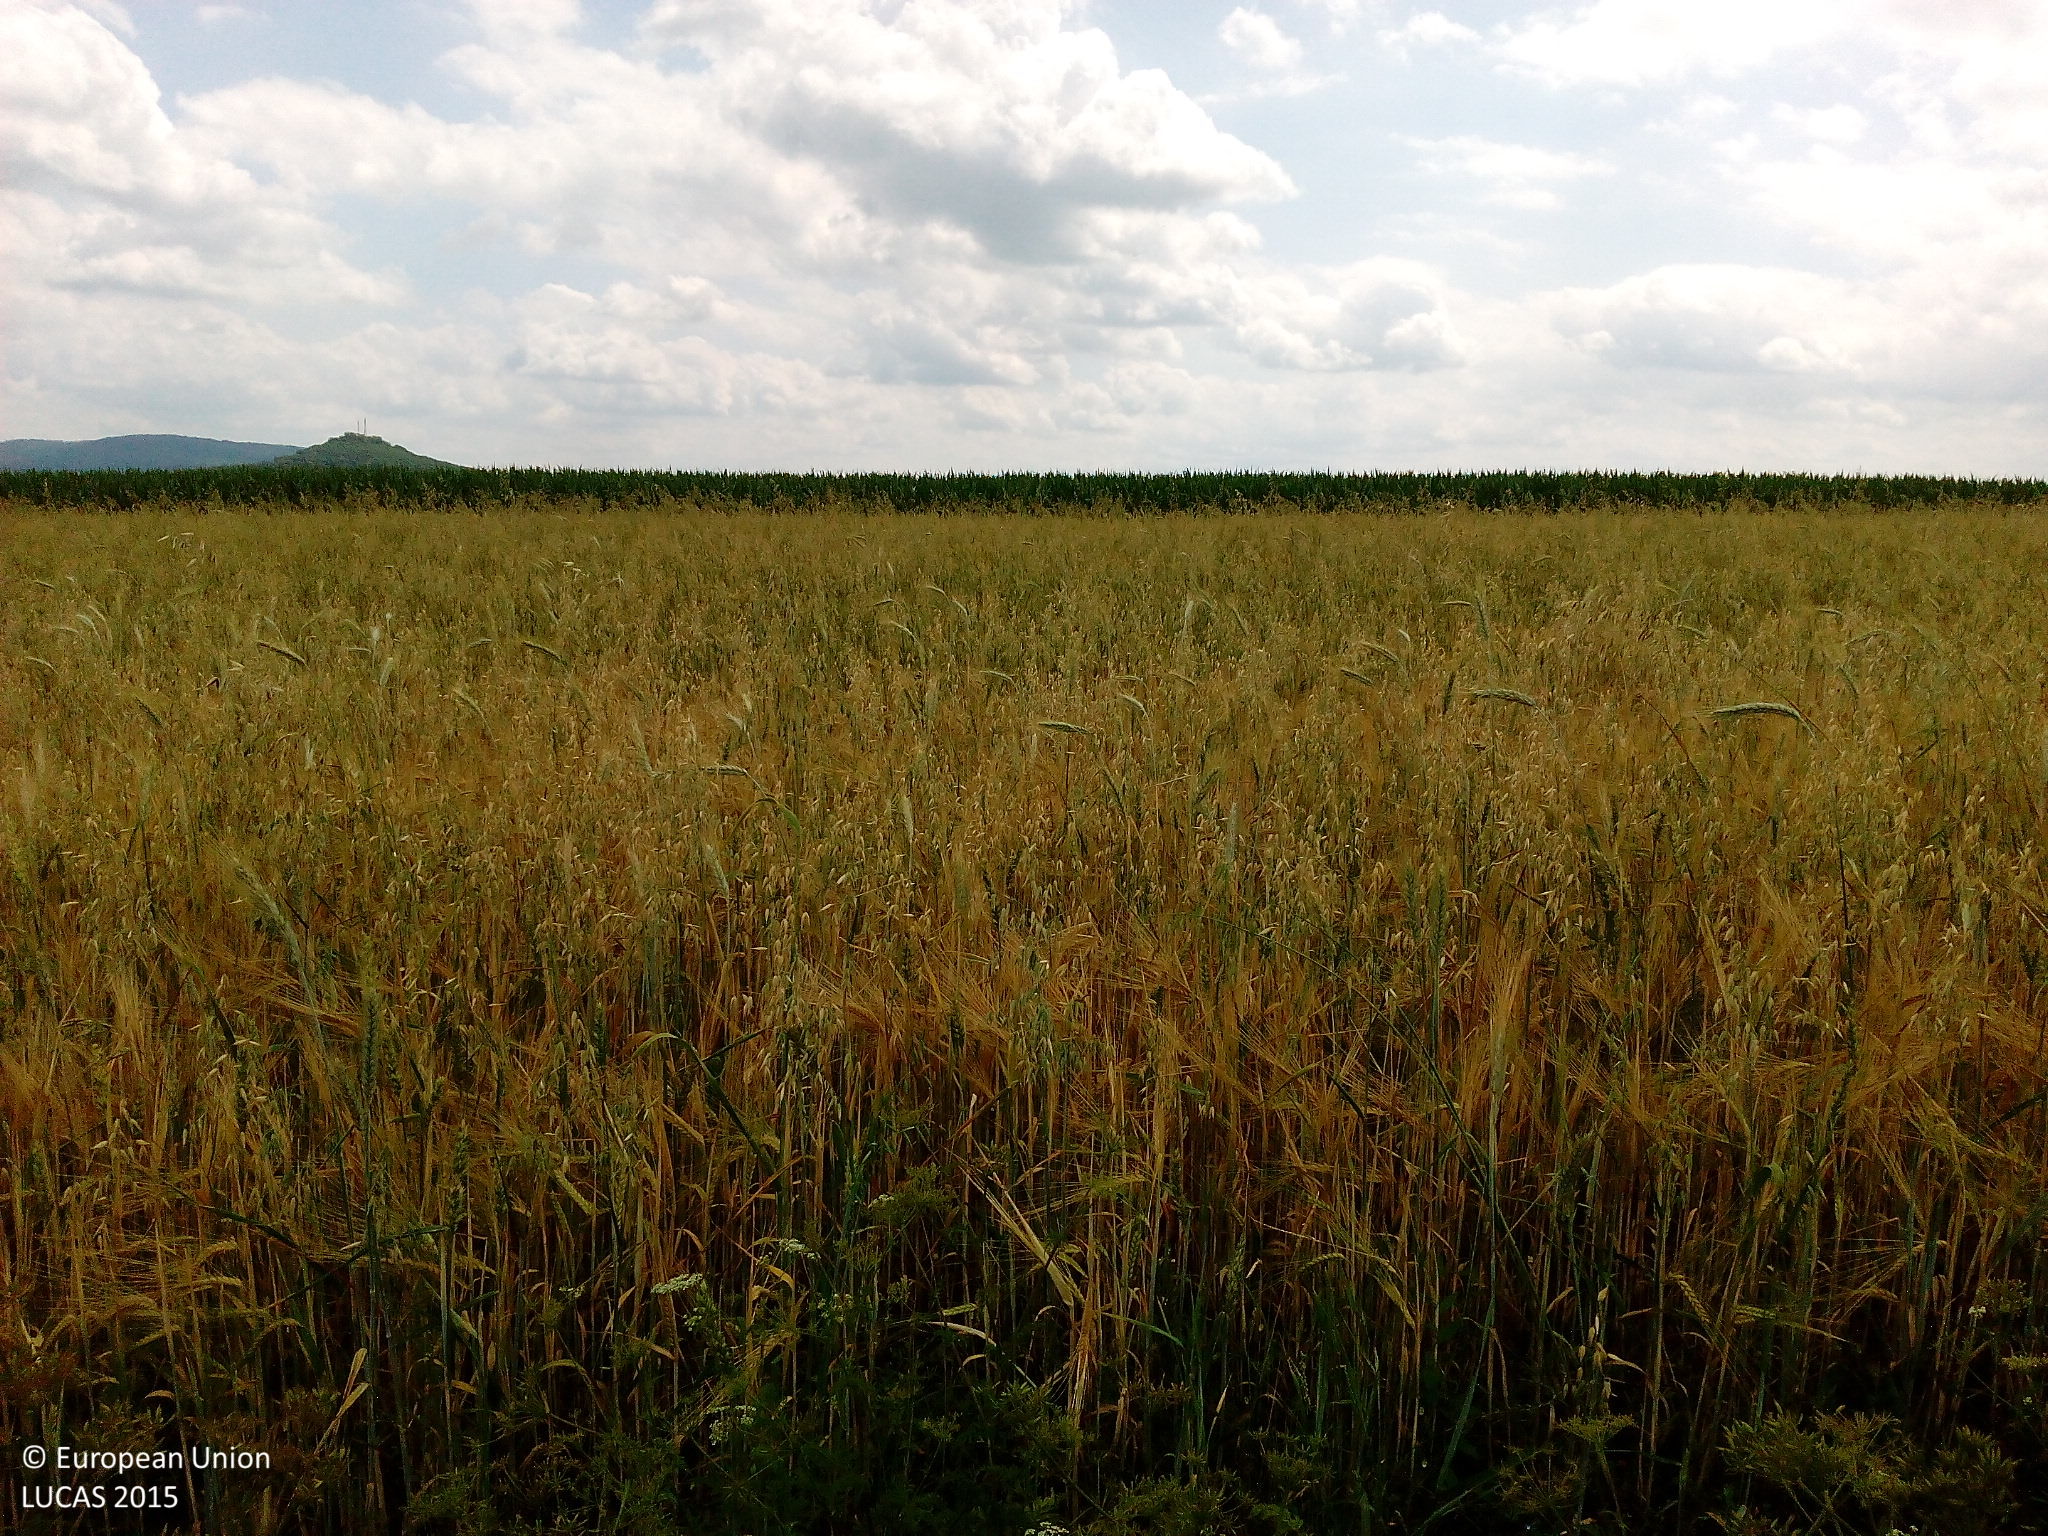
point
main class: Cropland
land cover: Mixed cereals for fodder
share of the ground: > 75 %
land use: Agriculture (excluding fallow land and kitchen gardens)
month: July
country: DE
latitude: 50.6876
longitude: 9.9009
